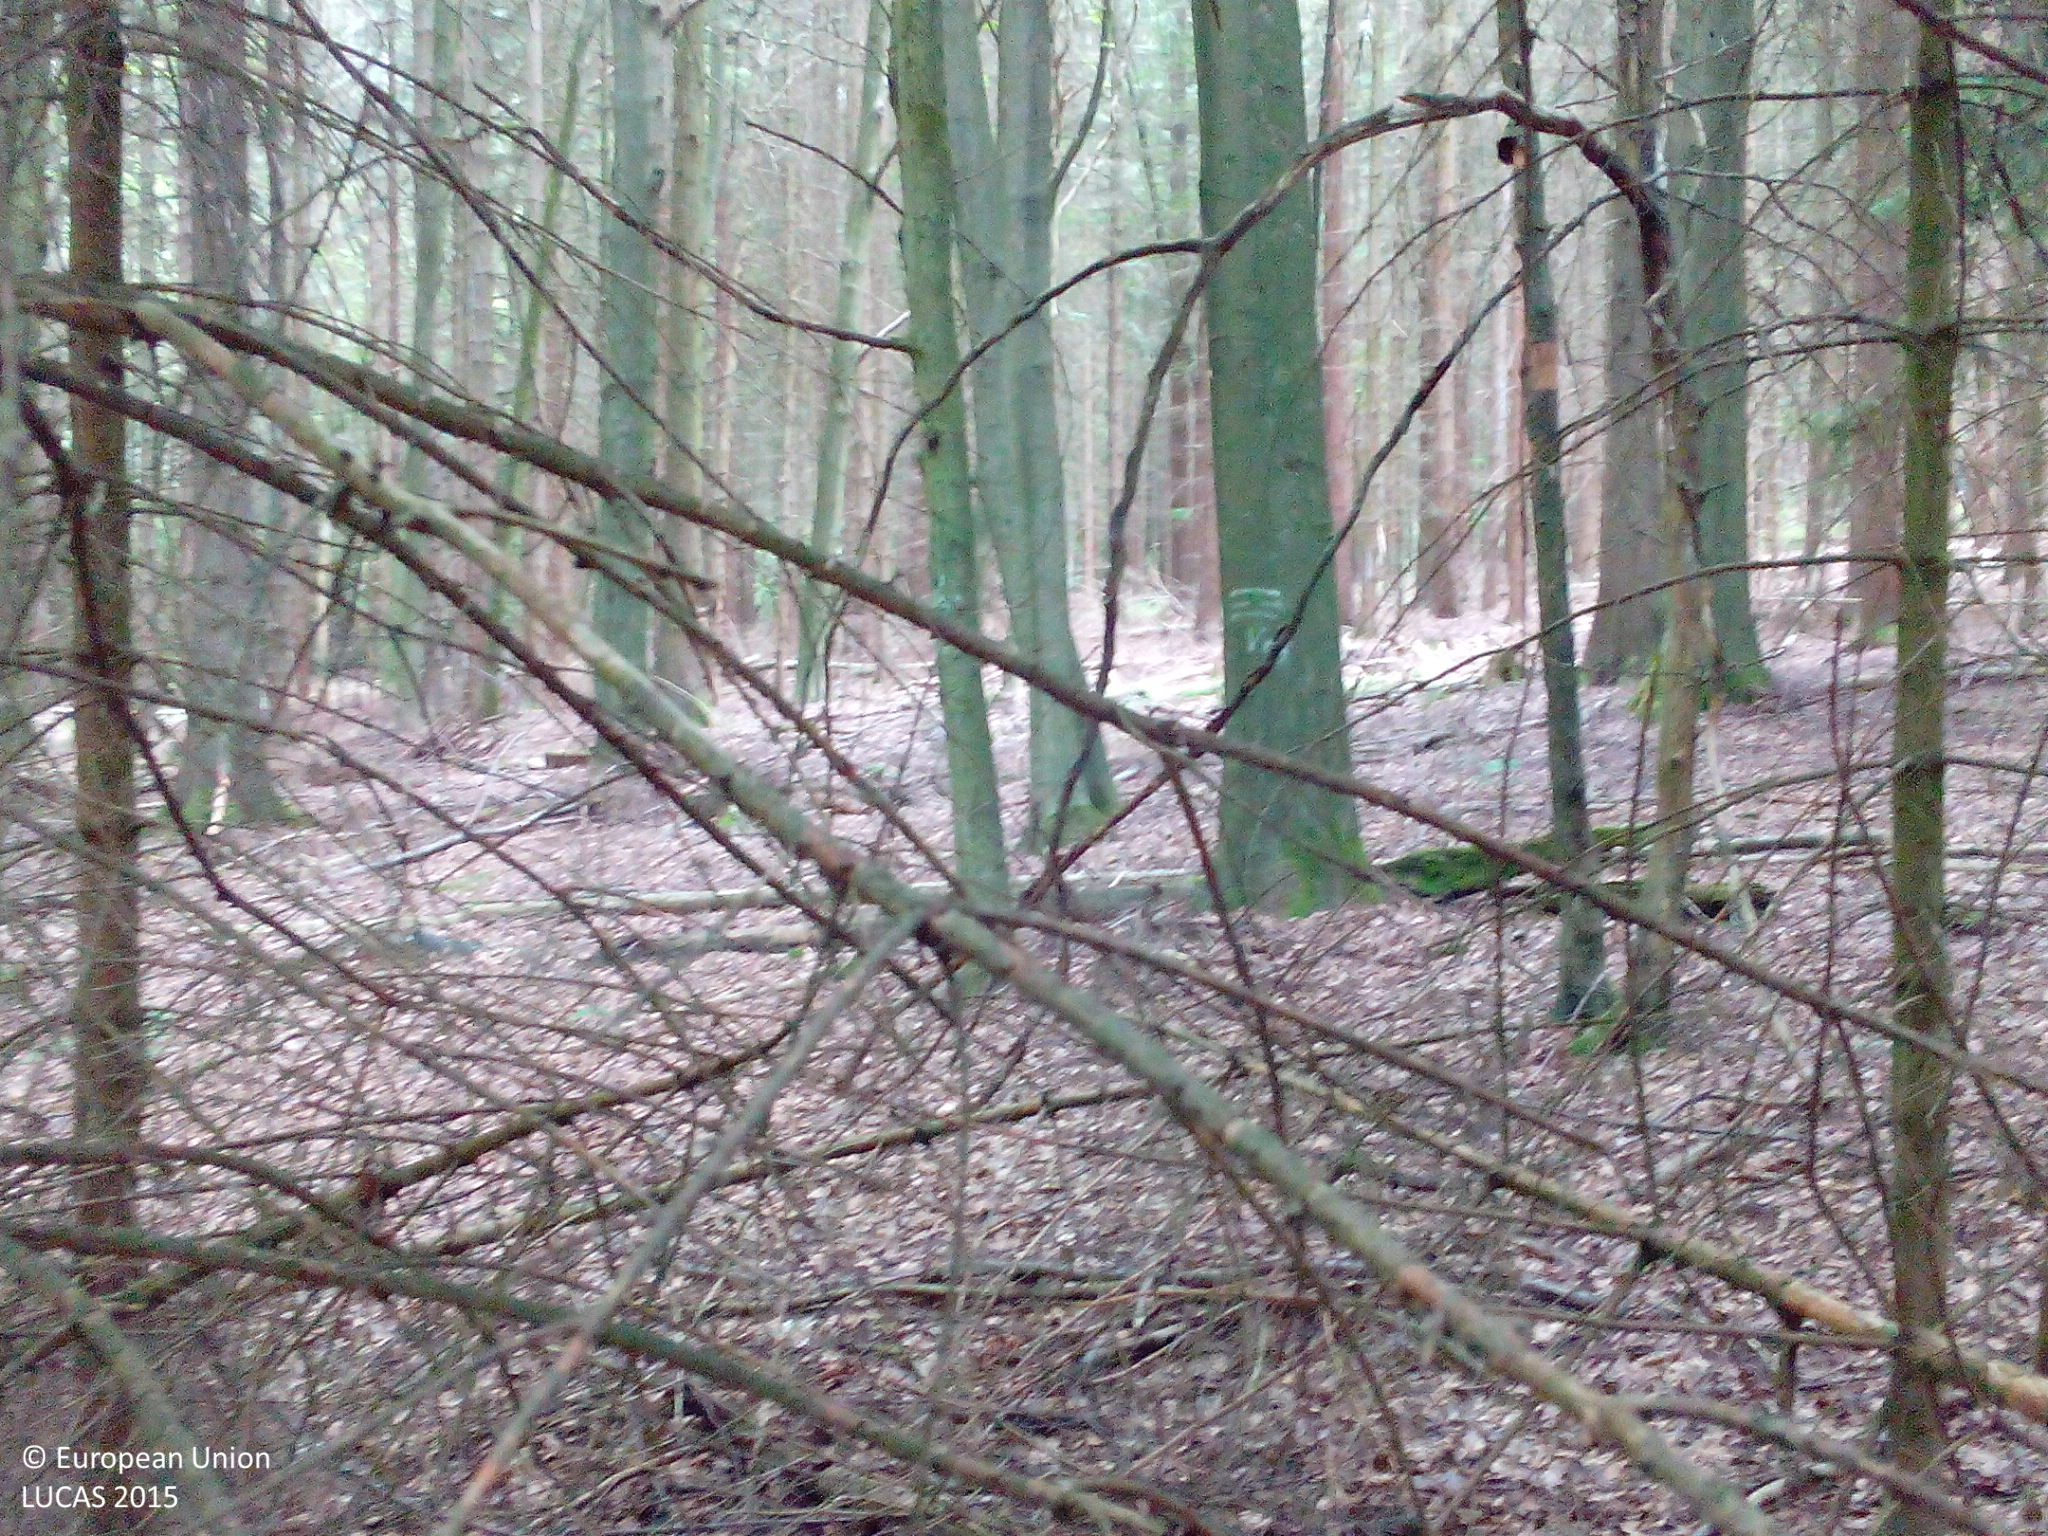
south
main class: Woodland
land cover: Spruce dominated mixed woodland
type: hemiboreal forest and nemoral coniferous forest and mixed broadleaved-coniferous forest
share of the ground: > 75 %
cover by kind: coniferous forest trees 70 %, broadleaved forest trees 30 %
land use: Forestry
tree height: > 5 m
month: July
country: DE
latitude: 50.5438
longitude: 9.9295
